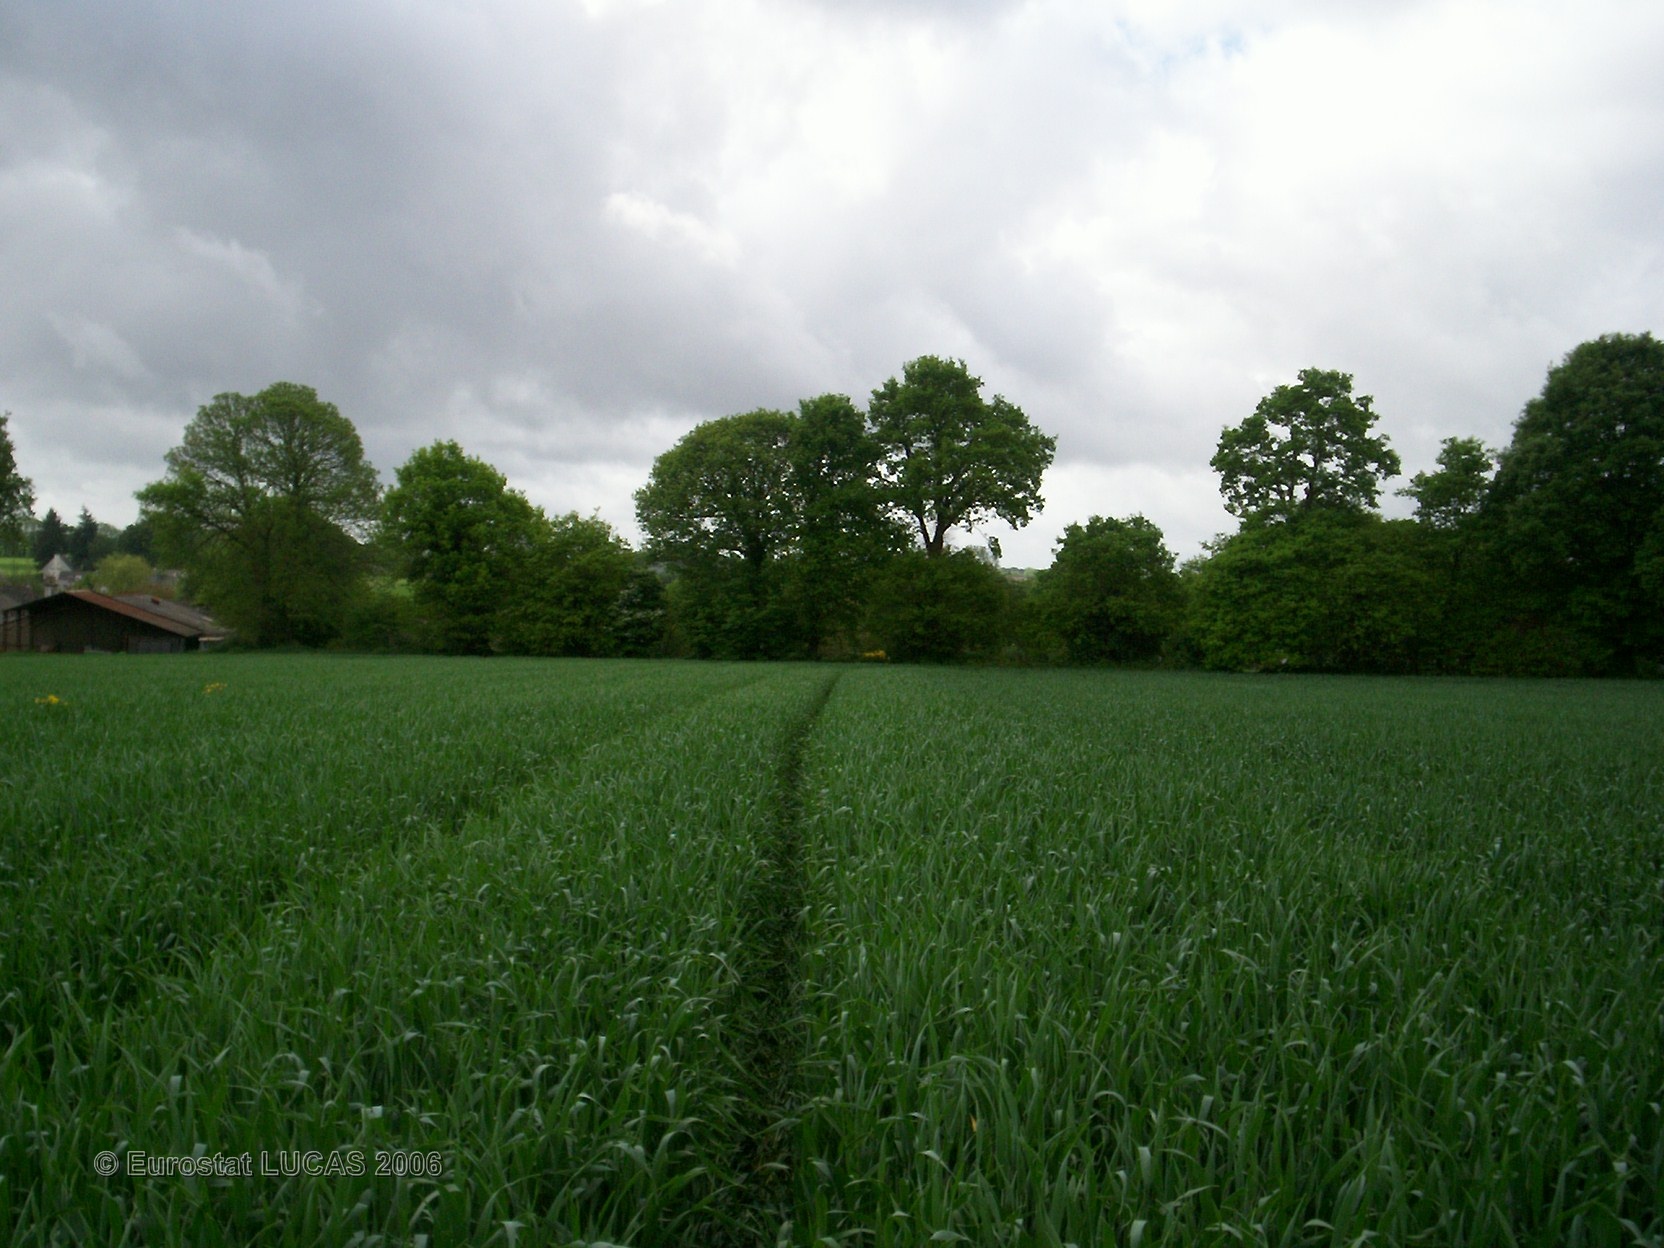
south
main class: Cropland
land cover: Common wheat
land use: Agriculture (excluding fallow land and kitchen gardens)
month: May
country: FR
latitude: 47.9352
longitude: -2.9028
